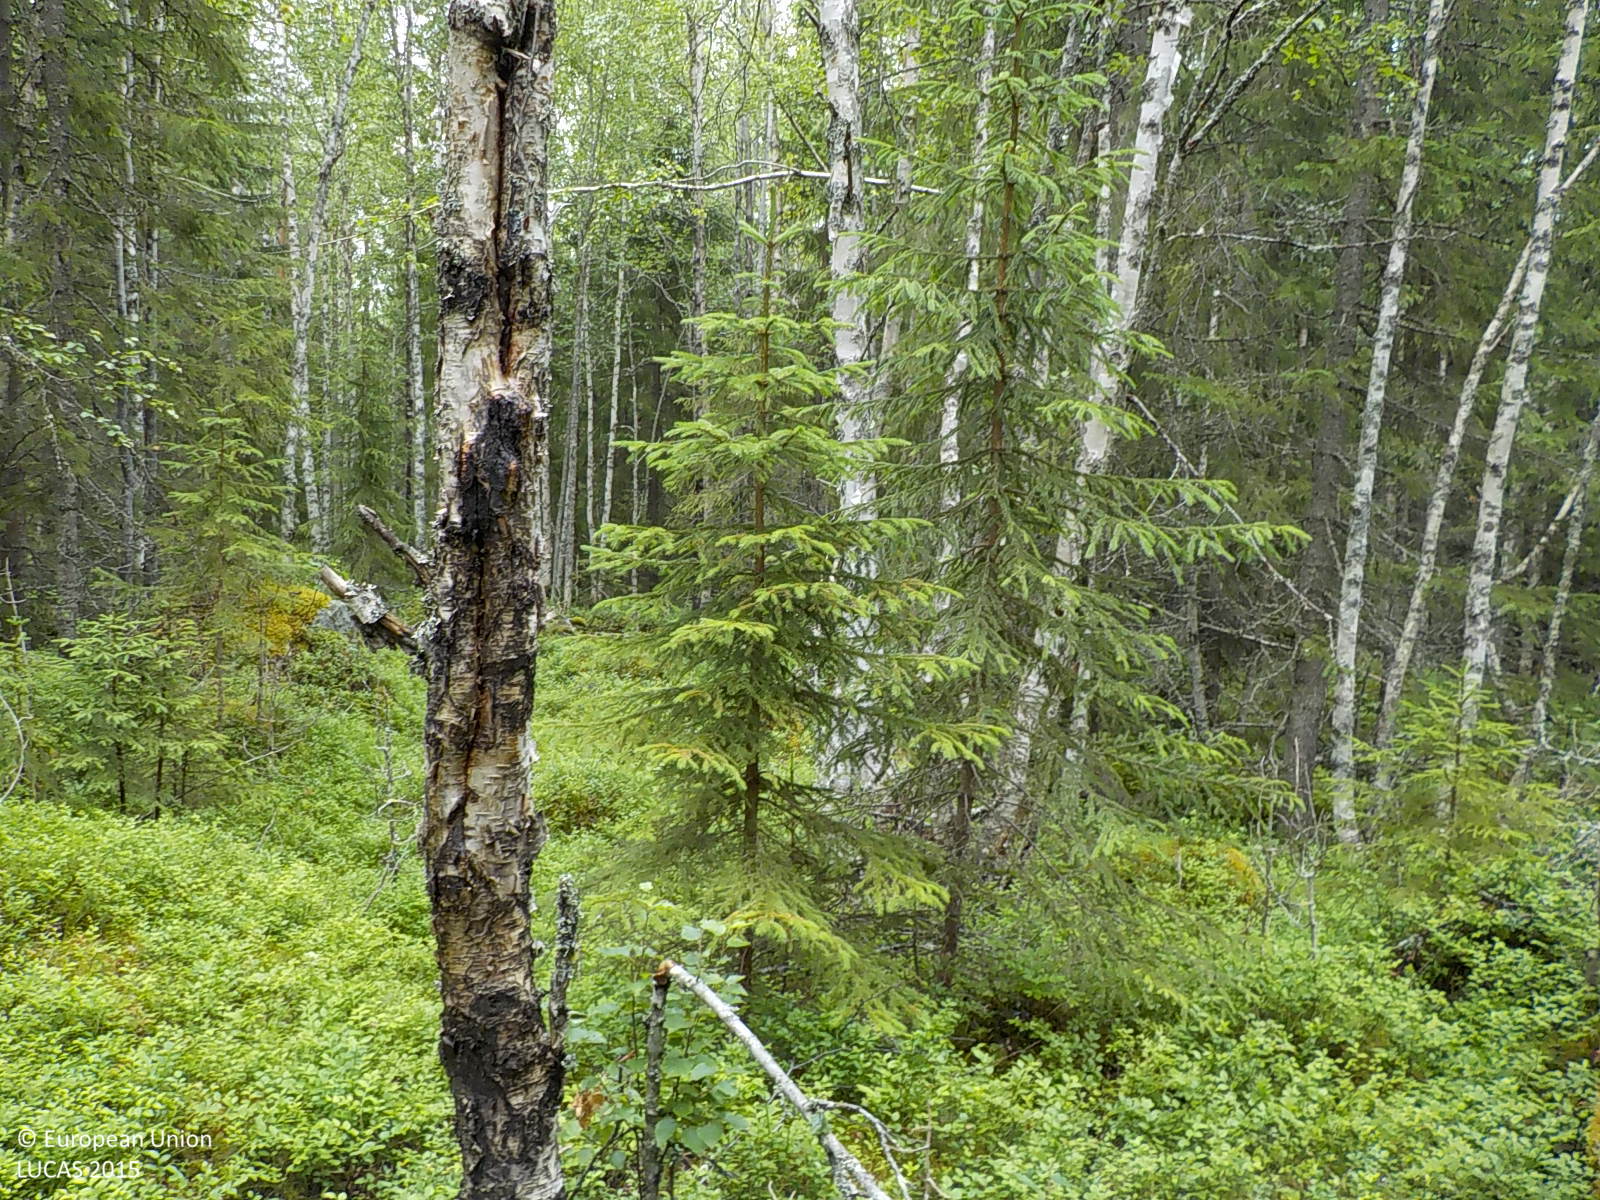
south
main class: Woodland
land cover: Other mixed woodland
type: boreal forest
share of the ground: > 75 %
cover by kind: coniferous forest trees 50 %, broadleaved forest trees 30 %, shrubs 10 %, lichens and mosses 5 %, consolidated bare surface 5 %
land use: Forestry
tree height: > 5 m
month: July
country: SE
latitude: 63.3430
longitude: 17.2668
